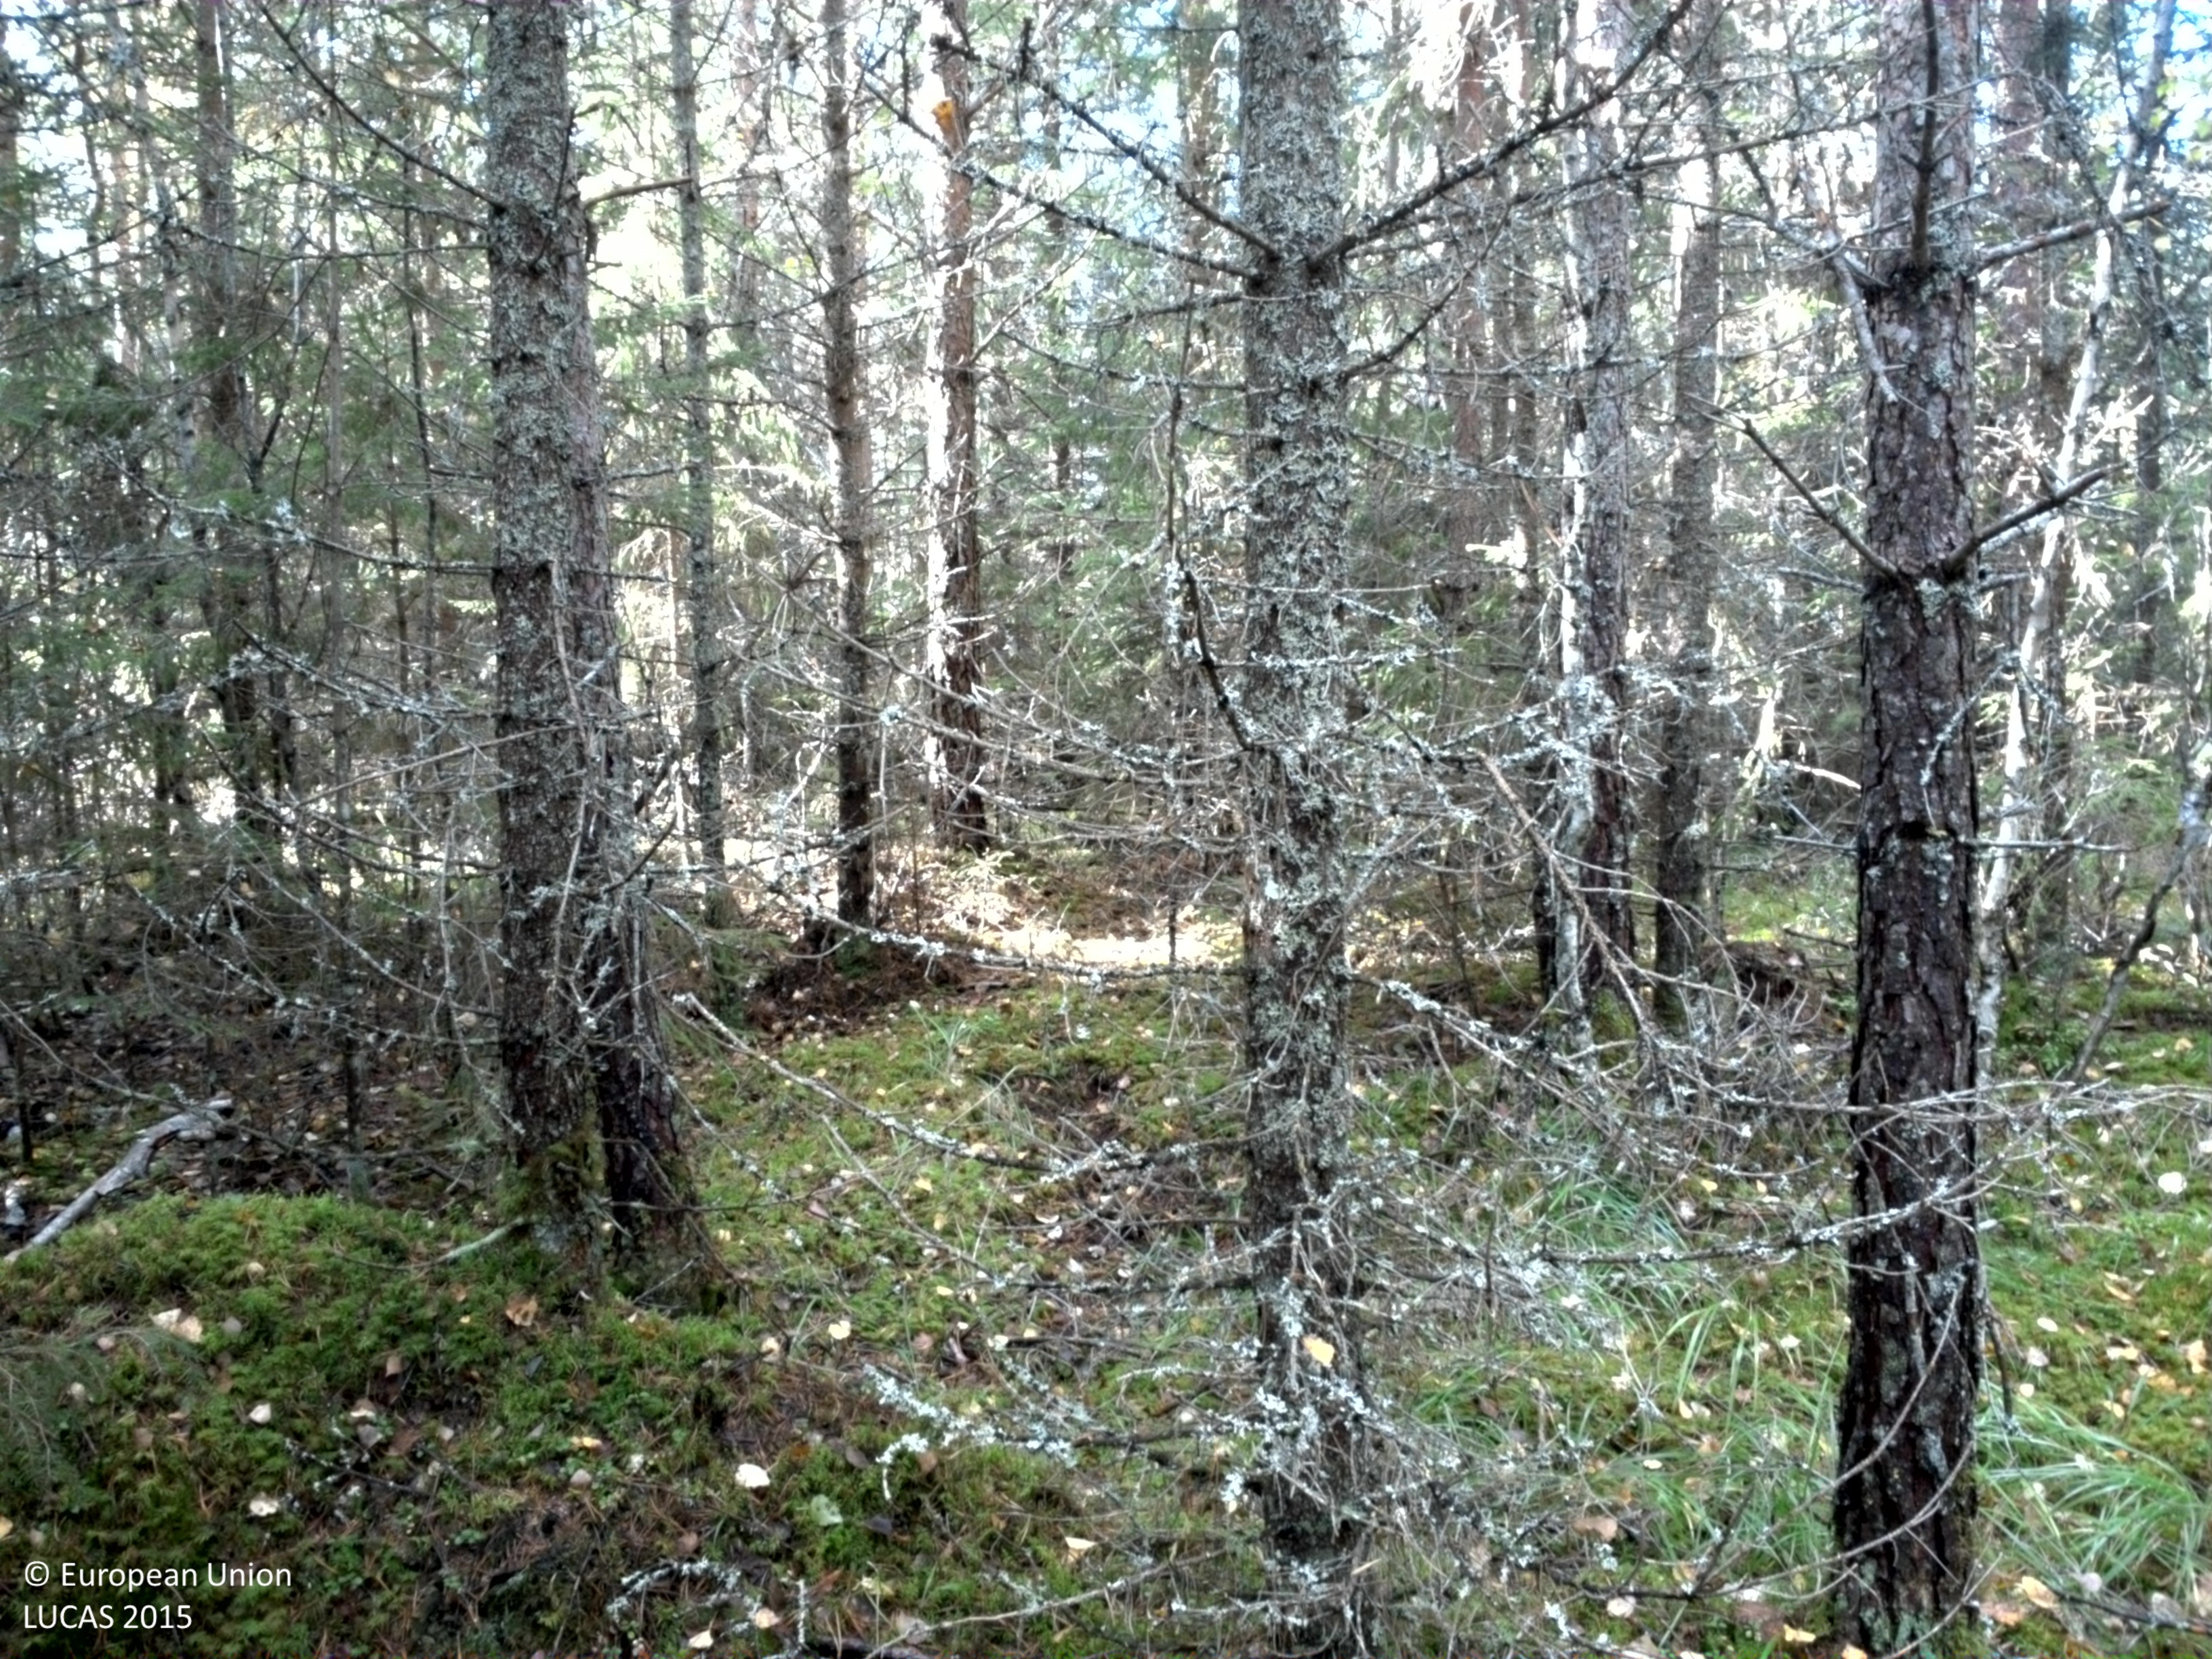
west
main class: Woodland
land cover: Pine dominated mixed woodland
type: boreal forest
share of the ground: 50 - 75 %
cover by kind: coniferous forest trees 45 %, lichens and mosses 30 %, broadleaved forest trees 15 %, herbaceous plants 10 %
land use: Forestry
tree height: > 5 m
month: September
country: SE
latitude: 60.1218
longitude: 16.4867
